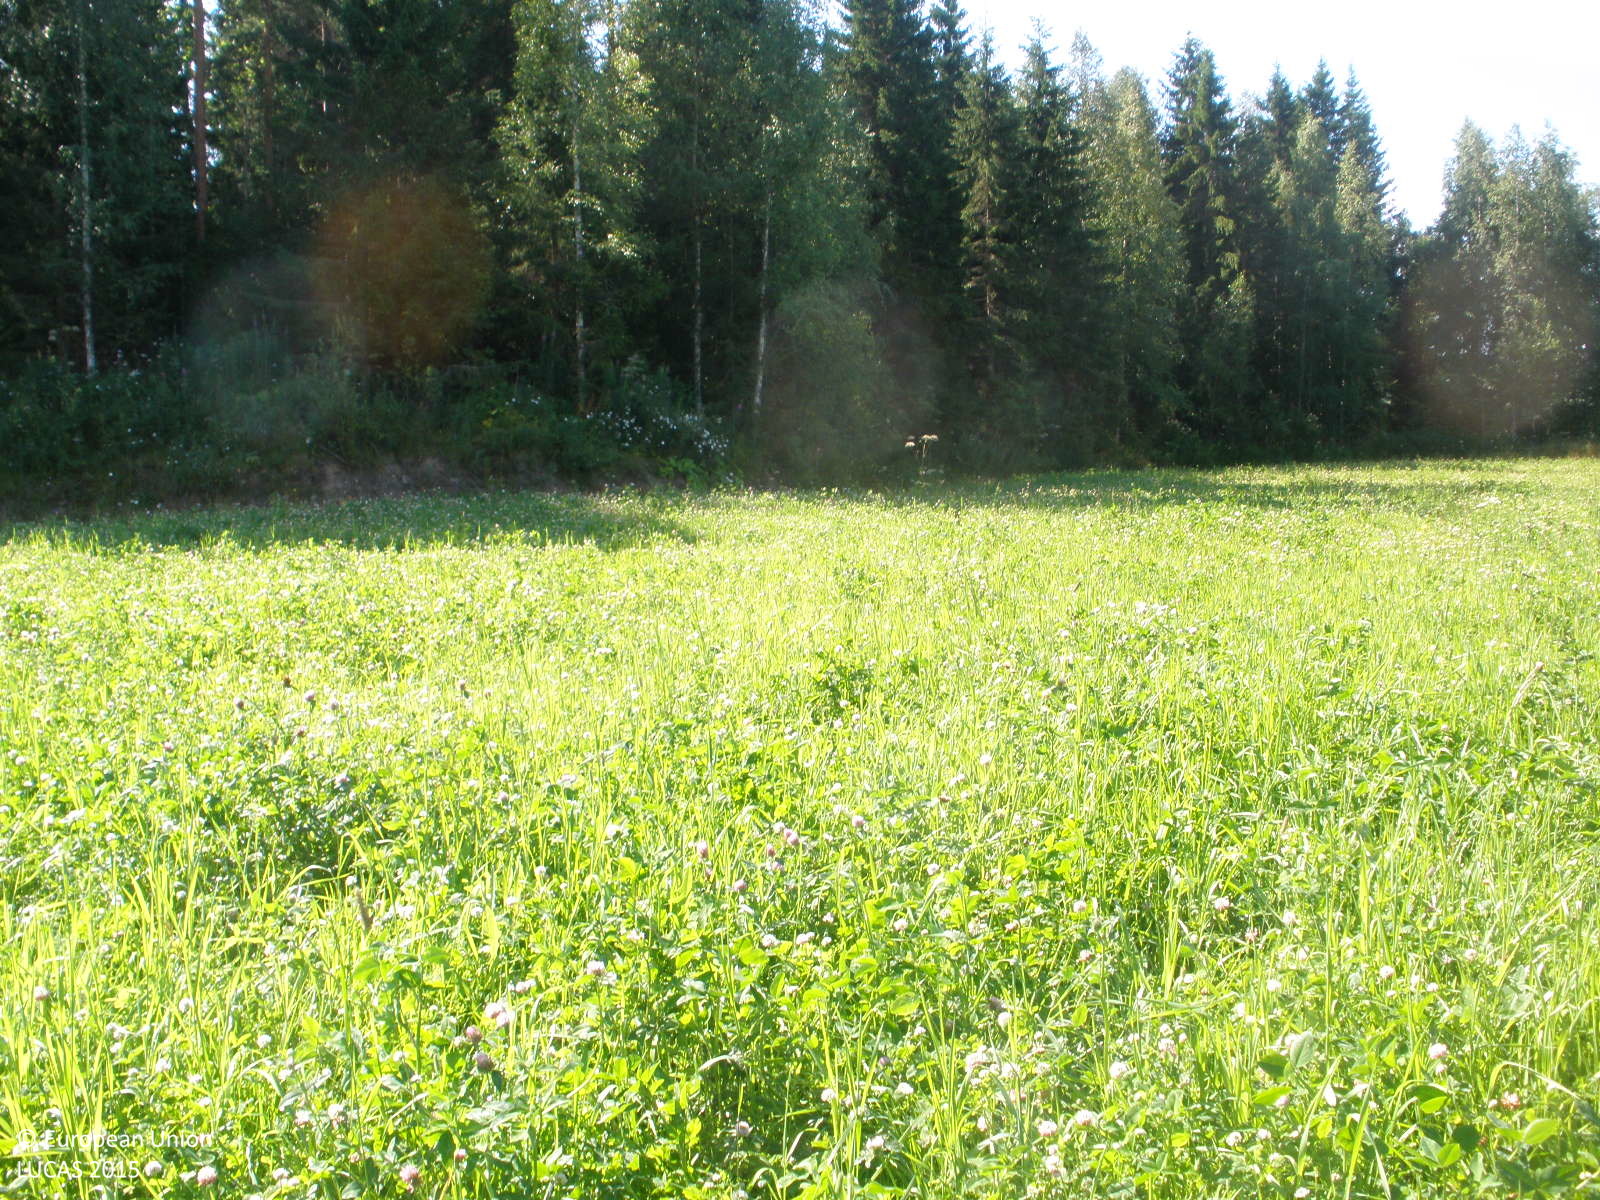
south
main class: Cropland
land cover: Other leguminous and mixtures for fodder
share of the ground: > 75 %
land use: Agriculture (excluding fallow land and kitchen gardens)
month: August
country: FI
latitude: 60.9551
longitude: 24.9775
